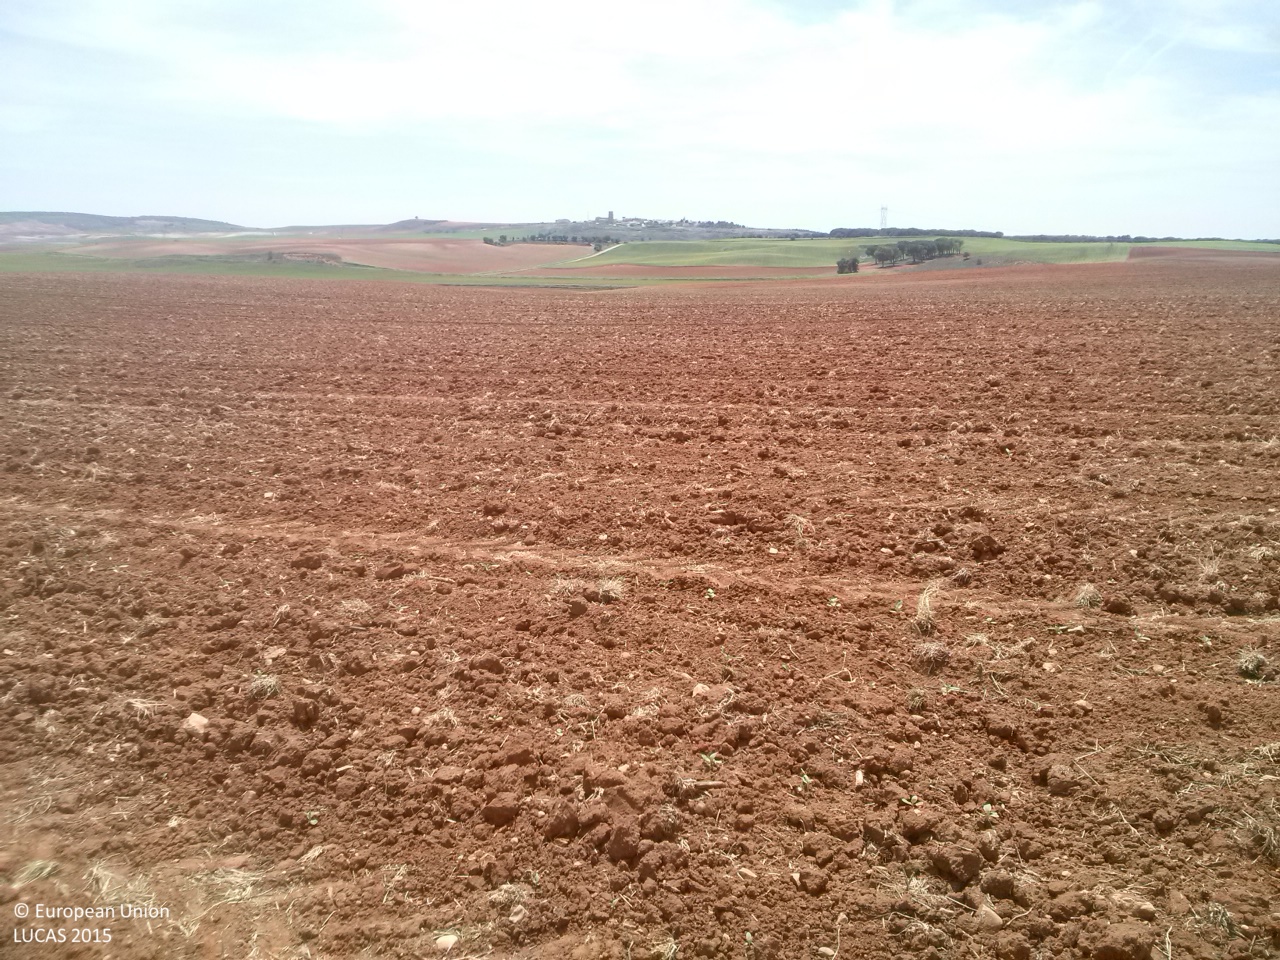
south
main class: Cropland
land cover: Sunflower
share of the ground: < 10 %
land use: Agriculture (excluding fallow land and kitchen gardens)
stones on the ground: 25 - 50 %
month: May
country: ES
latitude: 39.7580
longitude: -2.4929
